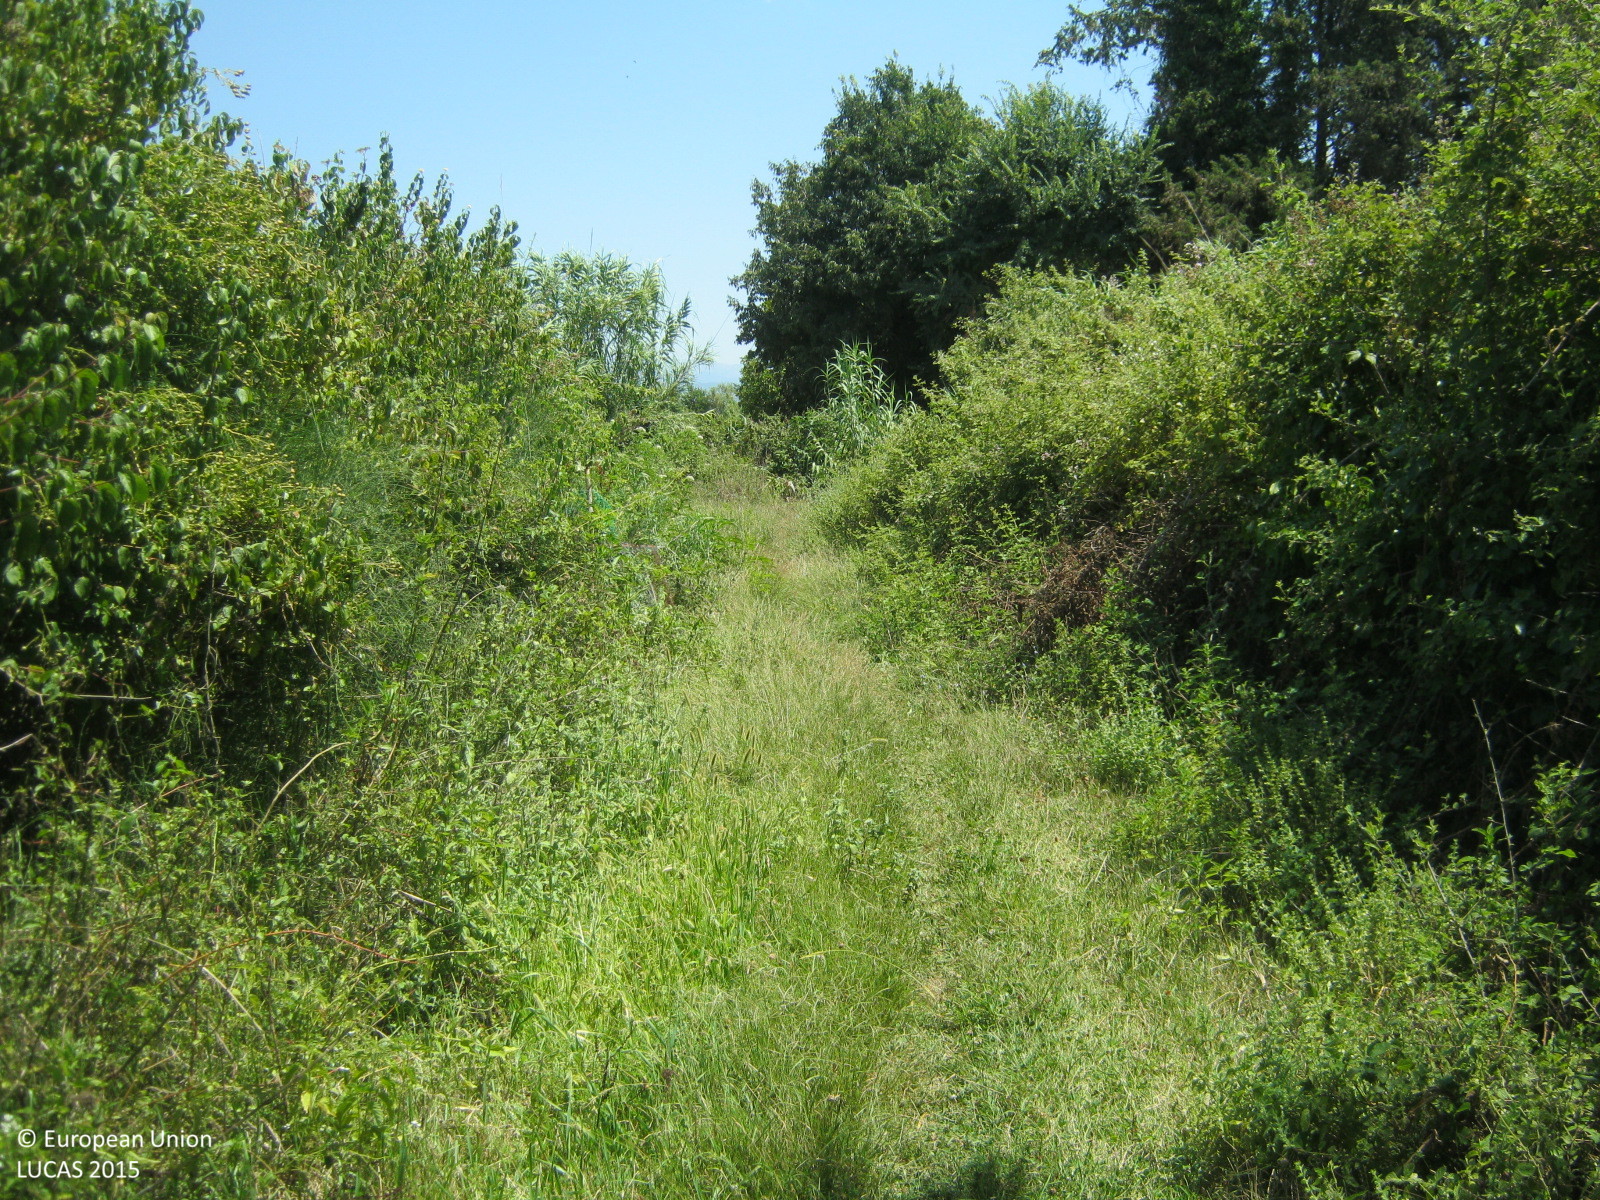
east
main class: Cropland
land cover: Oranges
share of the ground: > 75 %
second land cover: Spontaneously vegetated surfaces
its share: > 75 %
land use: Agriculture (excluding fallow land and kitchen gardens)
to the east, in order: Abandoned hedges; Oranges; Spontaneously vegetated surfaces; Fences; Shrubland without tree cover; Tracks; Inland marshes; Rivers and streams; Inland marshes; Tracks; Shrubland with sparse tree cover; Fences; Oranges; Spontaneously vegetated surfaces; Fences; Tracks; Shrubland without tree cover; Ditches and canals; Grass margins; Paved roads, cycling and walking lanes; Electric lines; Grass margins; Ditches and canals; Shrubland with sparse tree cover; Spontaneously vegetated surfaces; Shrubland with sparse tree cover; Spontaneously vegetated surfaces
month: July
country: GR
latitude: 39.0900
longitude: 20.9212
